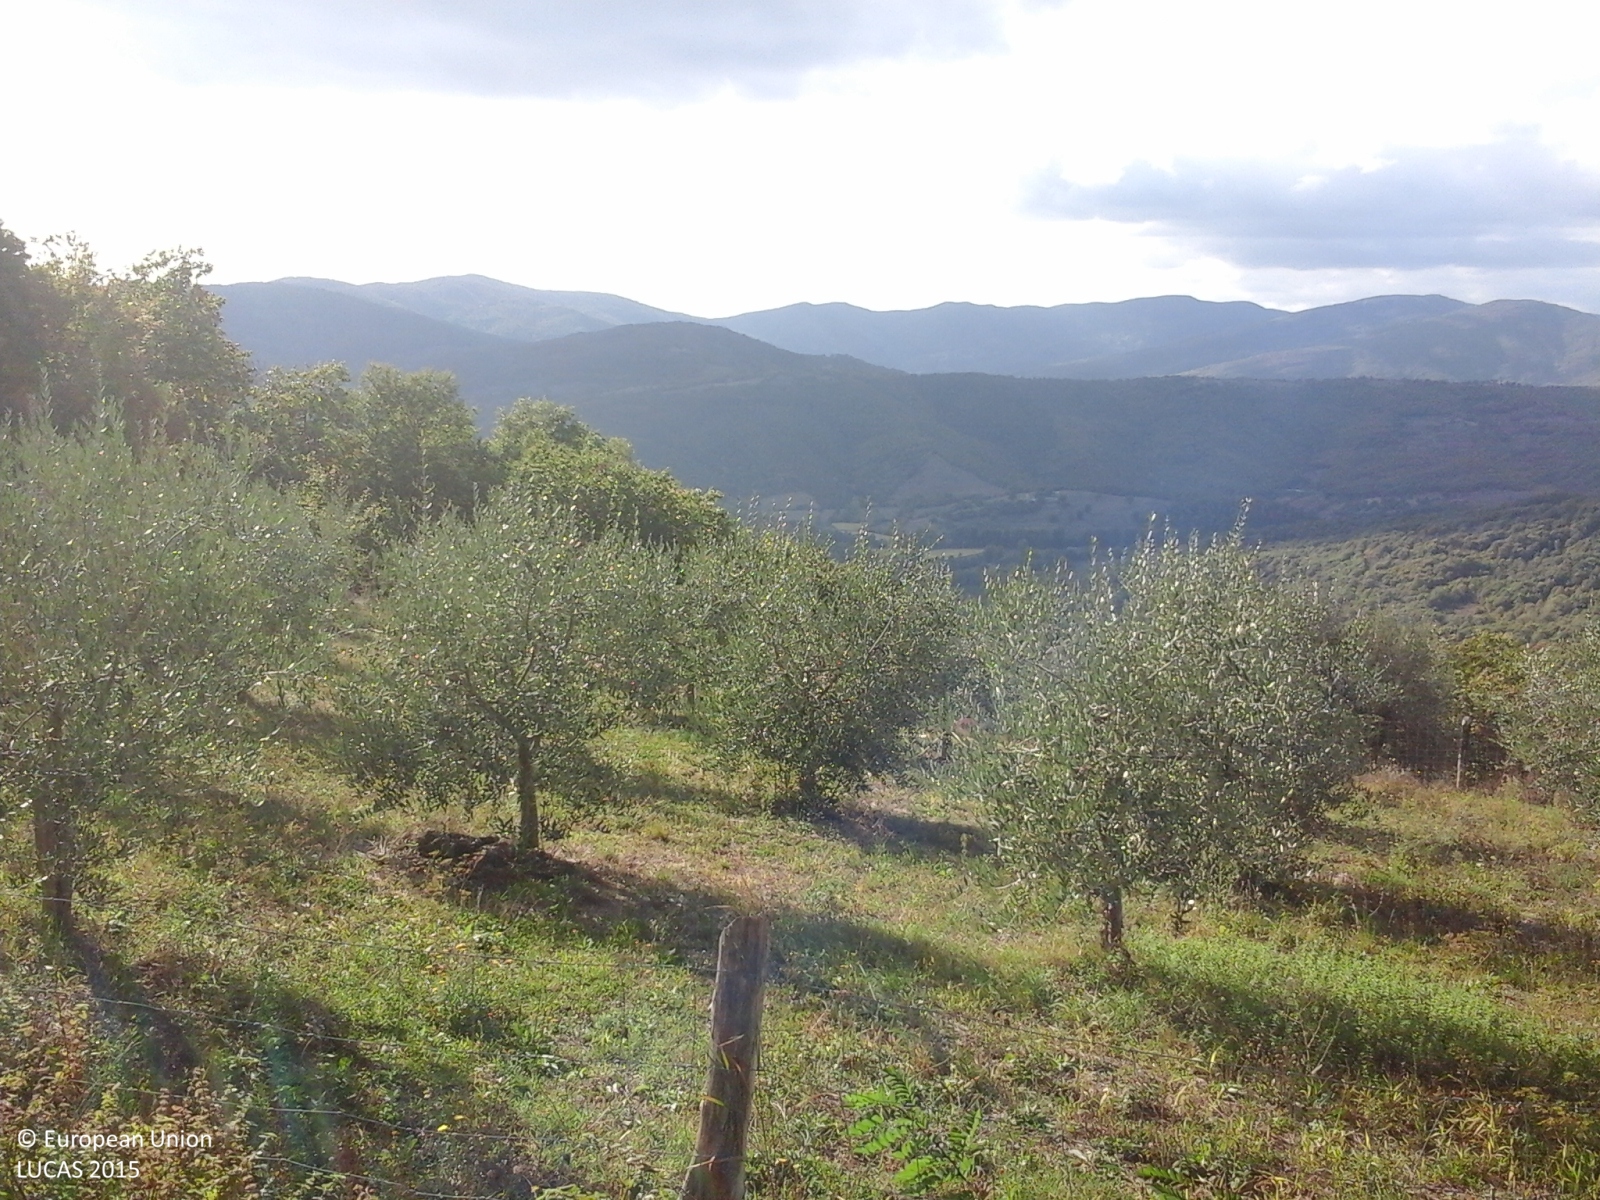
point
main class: Cropland
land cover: Olive groves
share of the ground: 50 - 75 %
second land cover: Spontaneously vegetated surfaces
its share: > 75 %
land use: Agriculture (excluding fallow land and kitchen gardens)
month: October
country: IT
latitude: 43.2438
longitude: 12.2228
